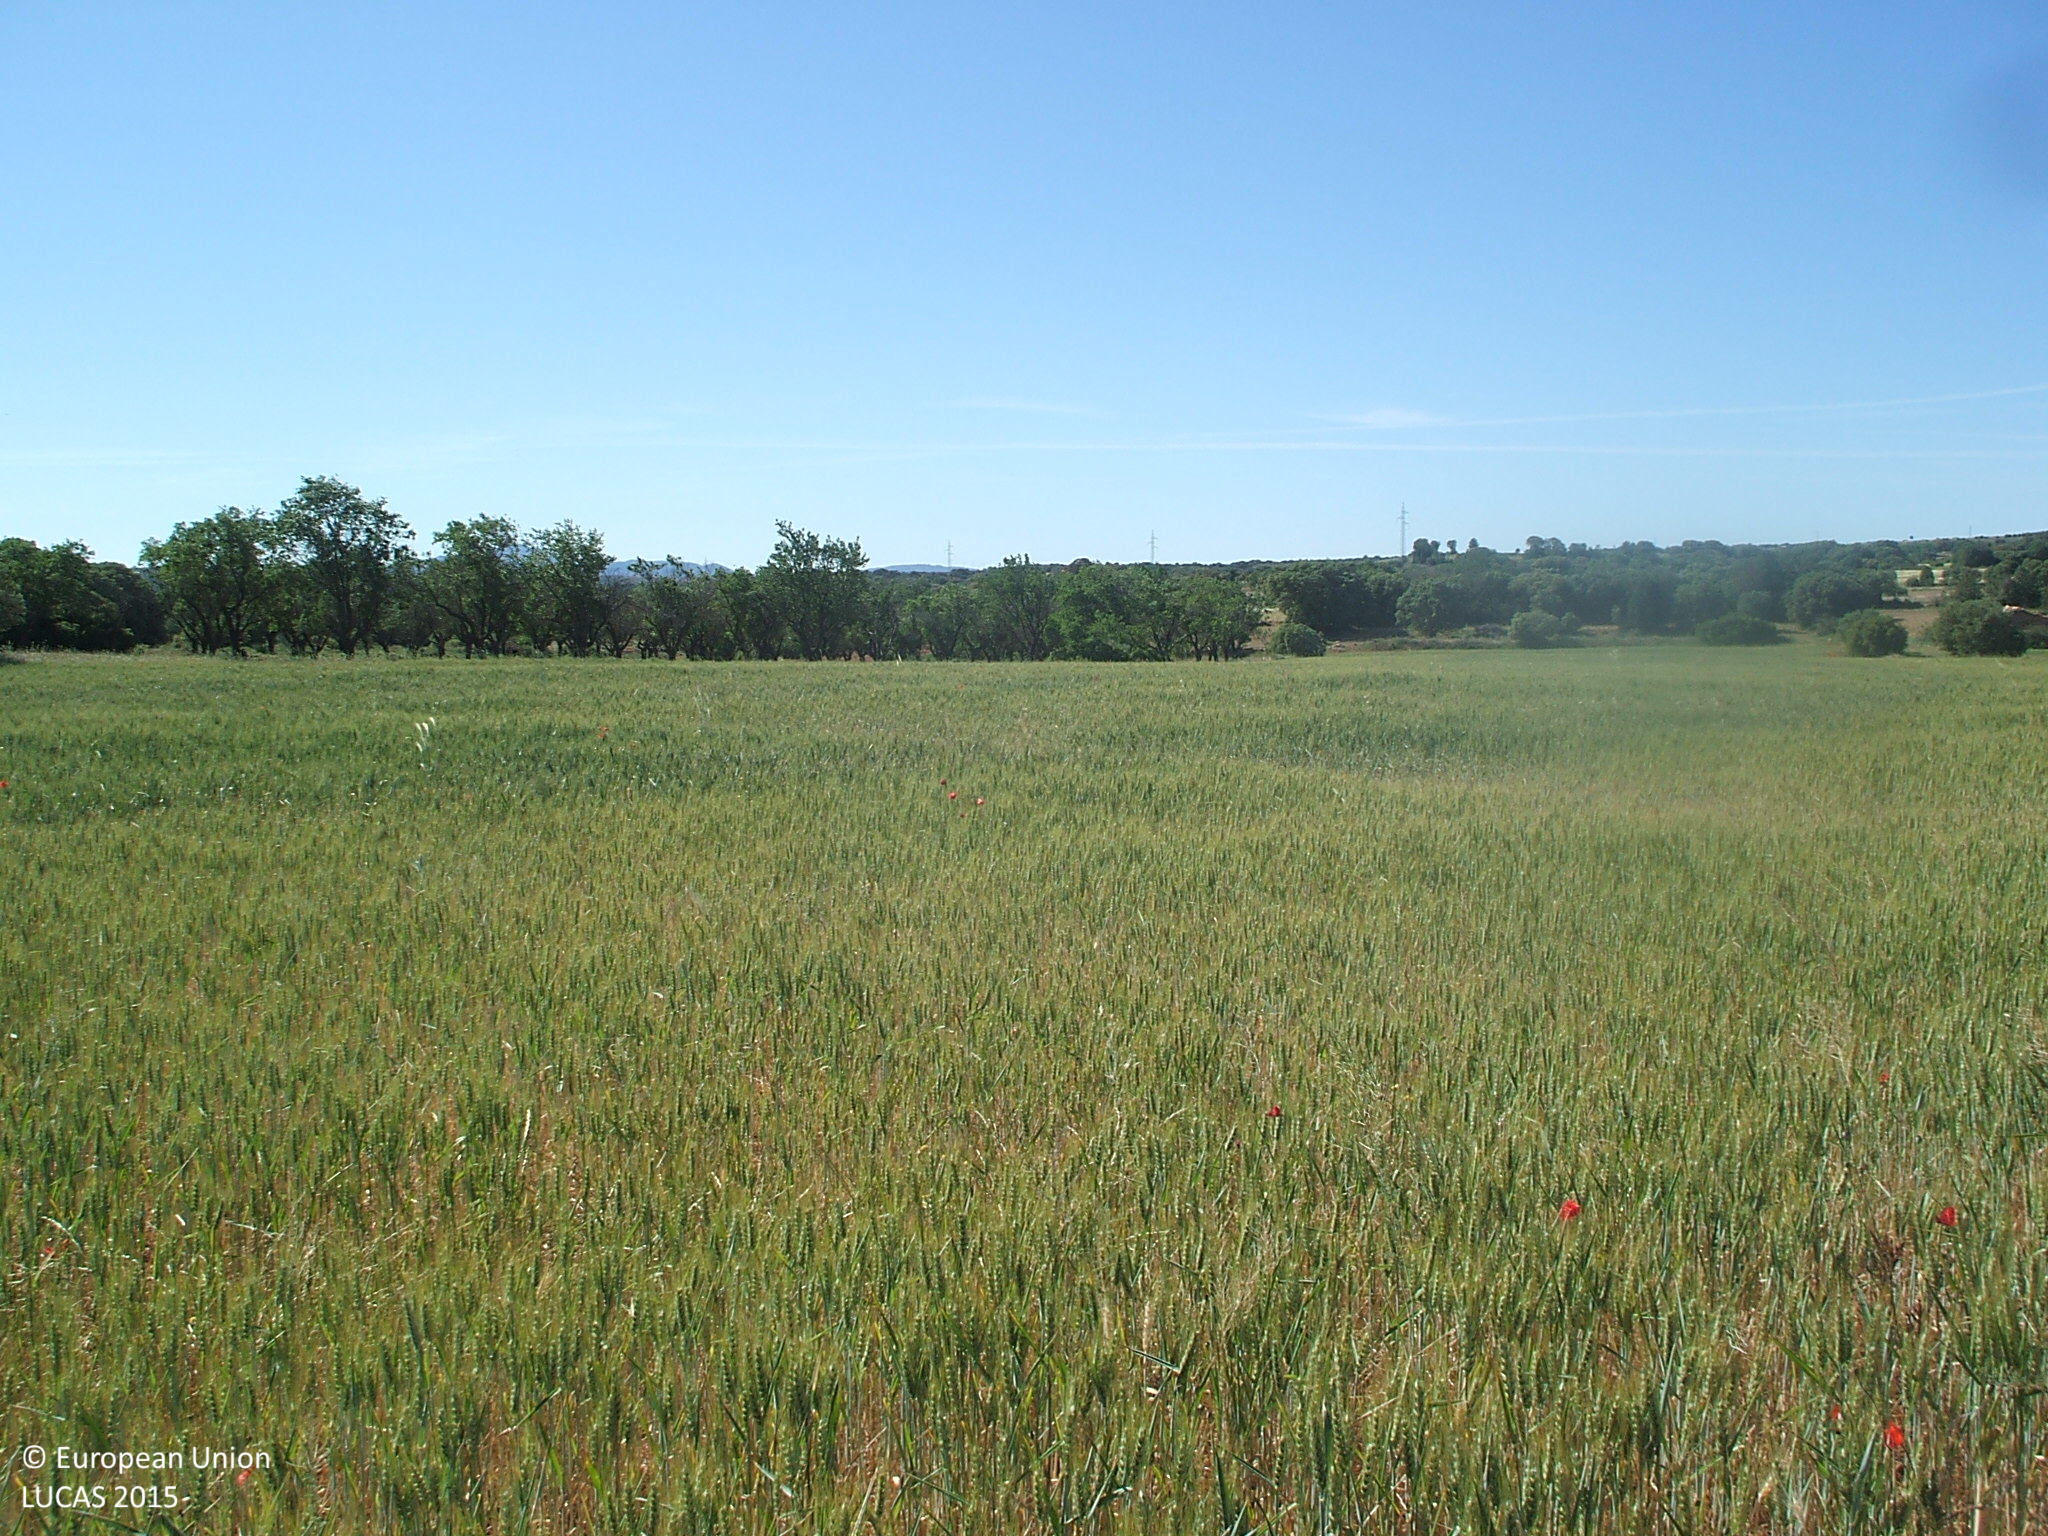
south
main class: Grassland
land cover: Spontaneously vegetated surfaces
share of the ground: > 75 %
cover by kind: herbaceous plants 100 %
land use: Fallow land
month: May
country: ES
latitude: 40.1621
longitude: -0.7968
